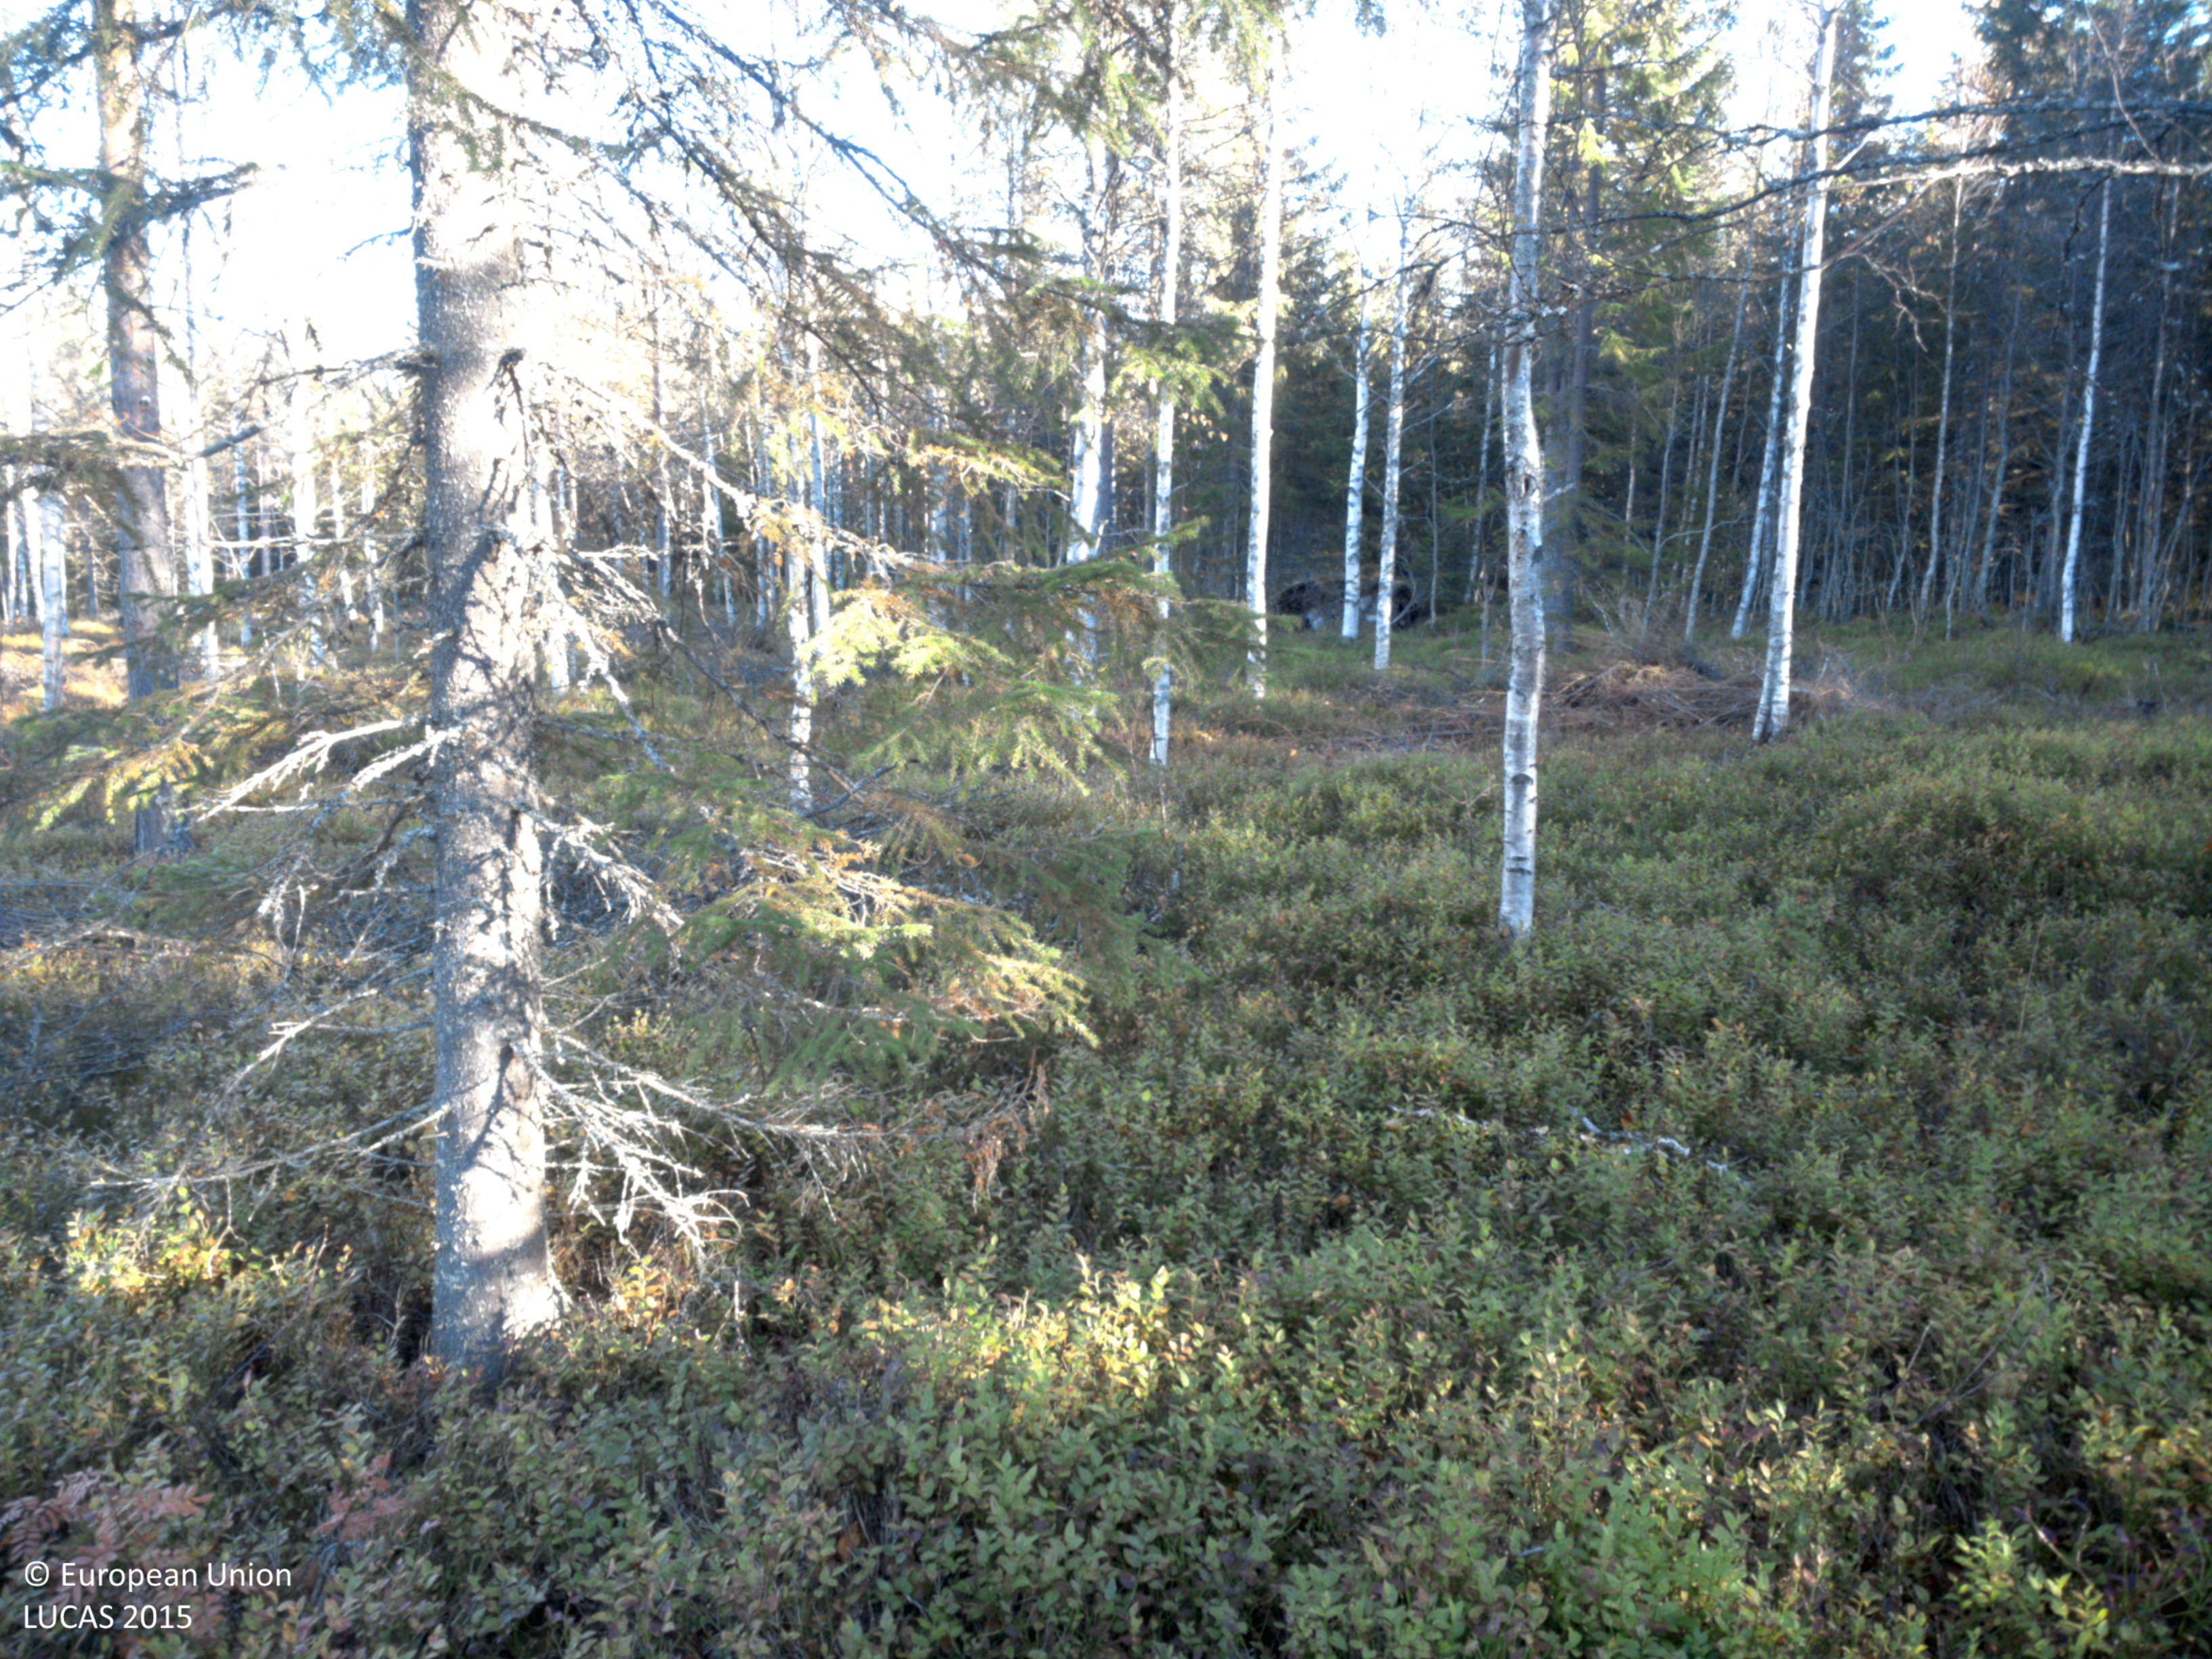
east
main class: Woodland
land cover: Spruce dominated mixed woodland
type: boreal forest
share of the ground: 50 - 75 %
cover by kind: coniferous forest trees 50 %, broadleaved forest trees 25 %, shrubs 15 %, herbaceous plants 5 %, lichens and mosses 5 %
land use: Forestry
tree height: > 5 m
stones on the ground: < 10 %
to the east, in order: Spruce dominated mixed woodland; Broadleaved woodland; Pine dominated mixed woodland; Ditches and canals; Spruce dominated coniferous woodland; Spruce dominated mixed woodland; Other coniferous woodland
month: October
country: SE
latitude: 64.0781
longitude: 18.8505
